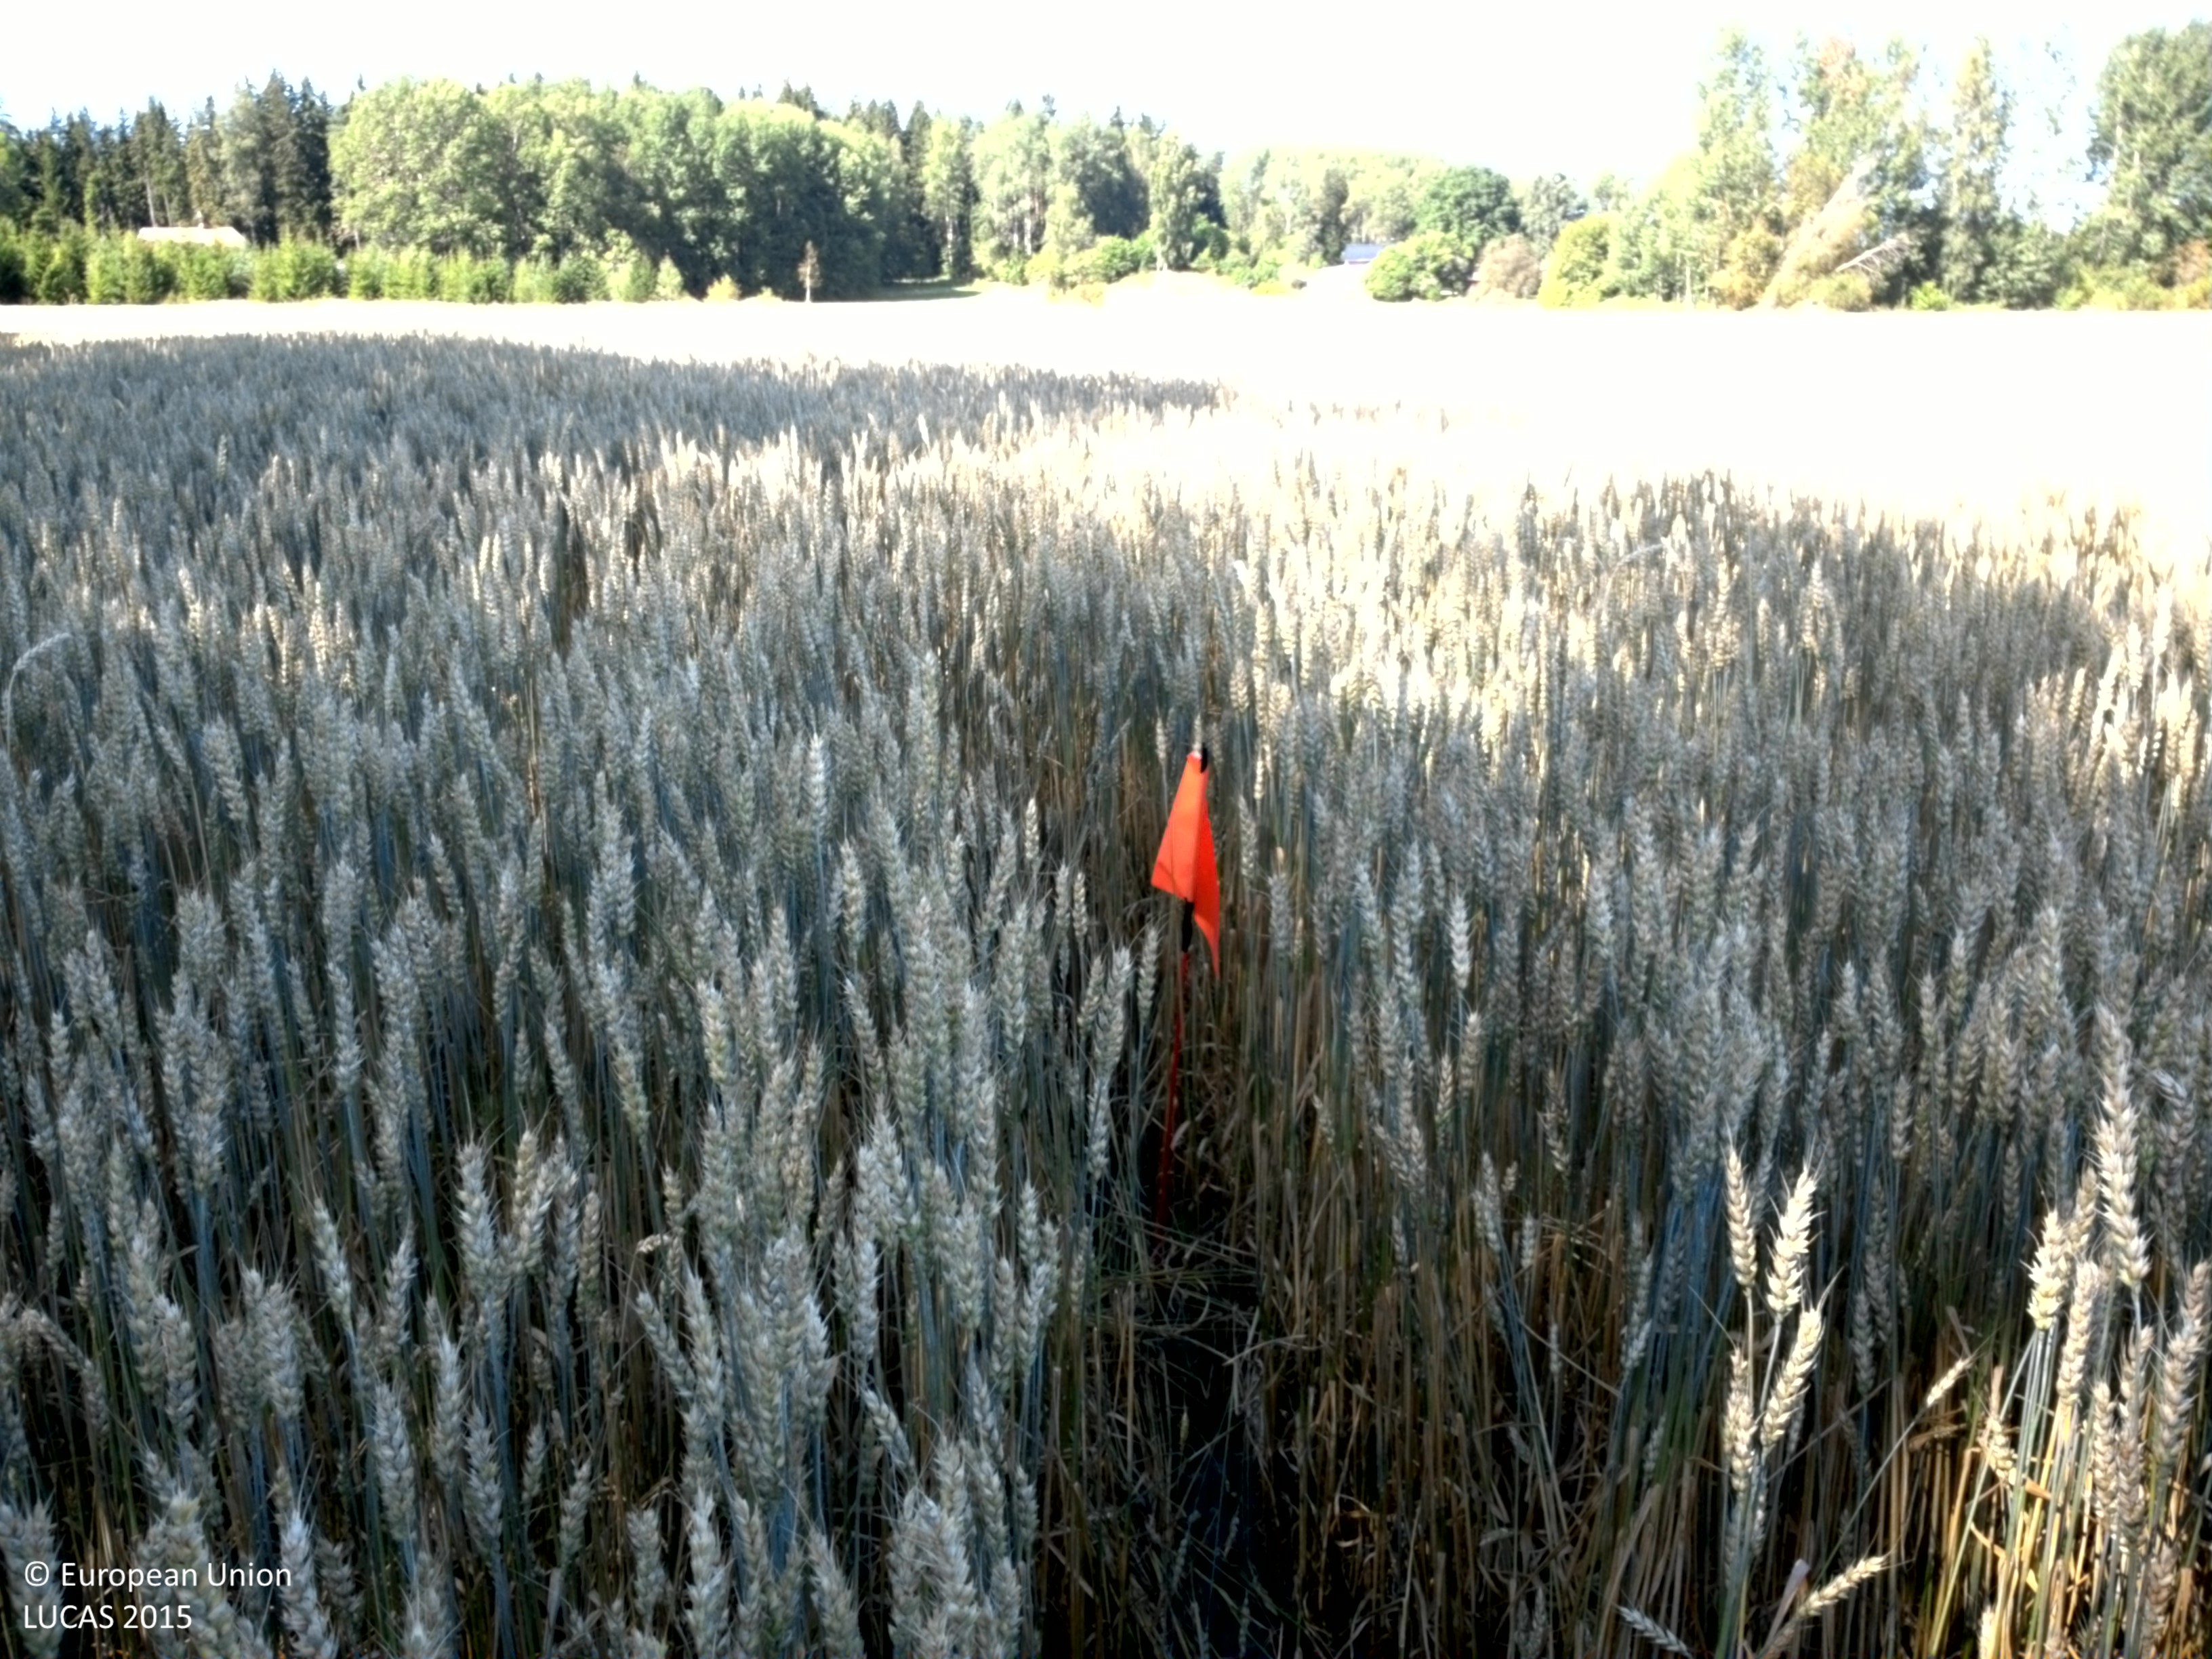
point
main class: Cropland
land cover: Common wheat
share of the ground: > 75 %
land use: Agriculture (excluding fallow land and kitchen gardens)
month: August
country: SE
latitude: 60.0269
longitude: 17.9804
